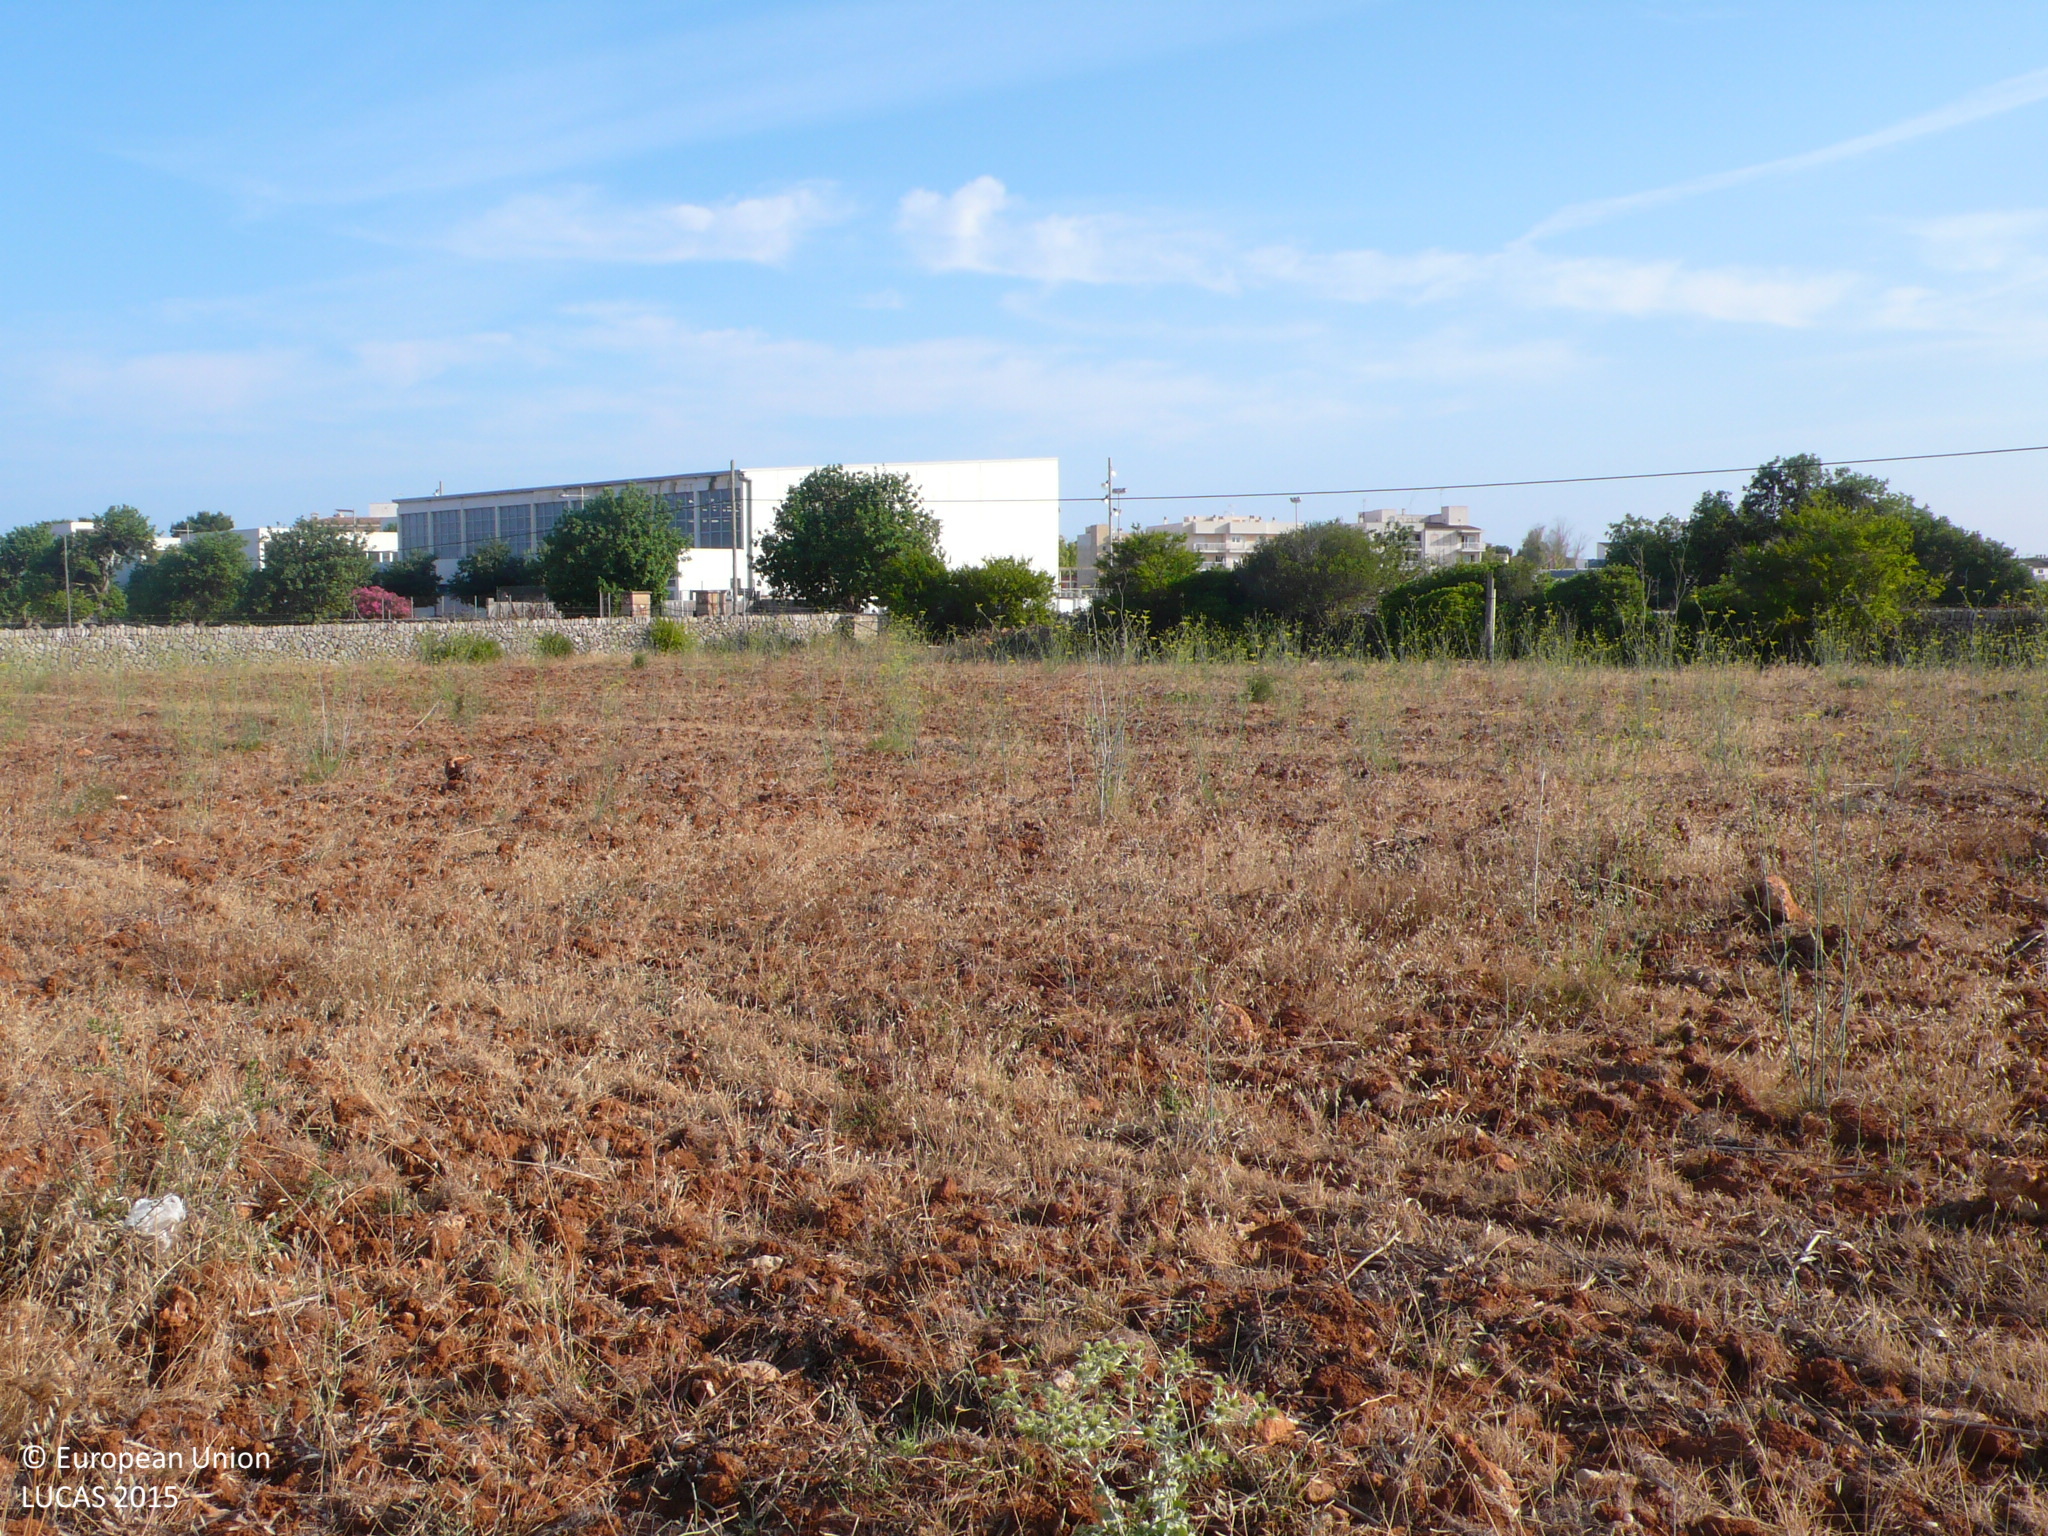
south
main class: Grassland
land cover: Spontaneously vegetated surfaces
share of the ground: 25 - 50 %
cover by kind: unconsolidated bare surface 65 %, herbaceous plants 35 %
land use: Fallow land
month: July
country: ES
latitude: 39.5504
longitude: 3.3384
